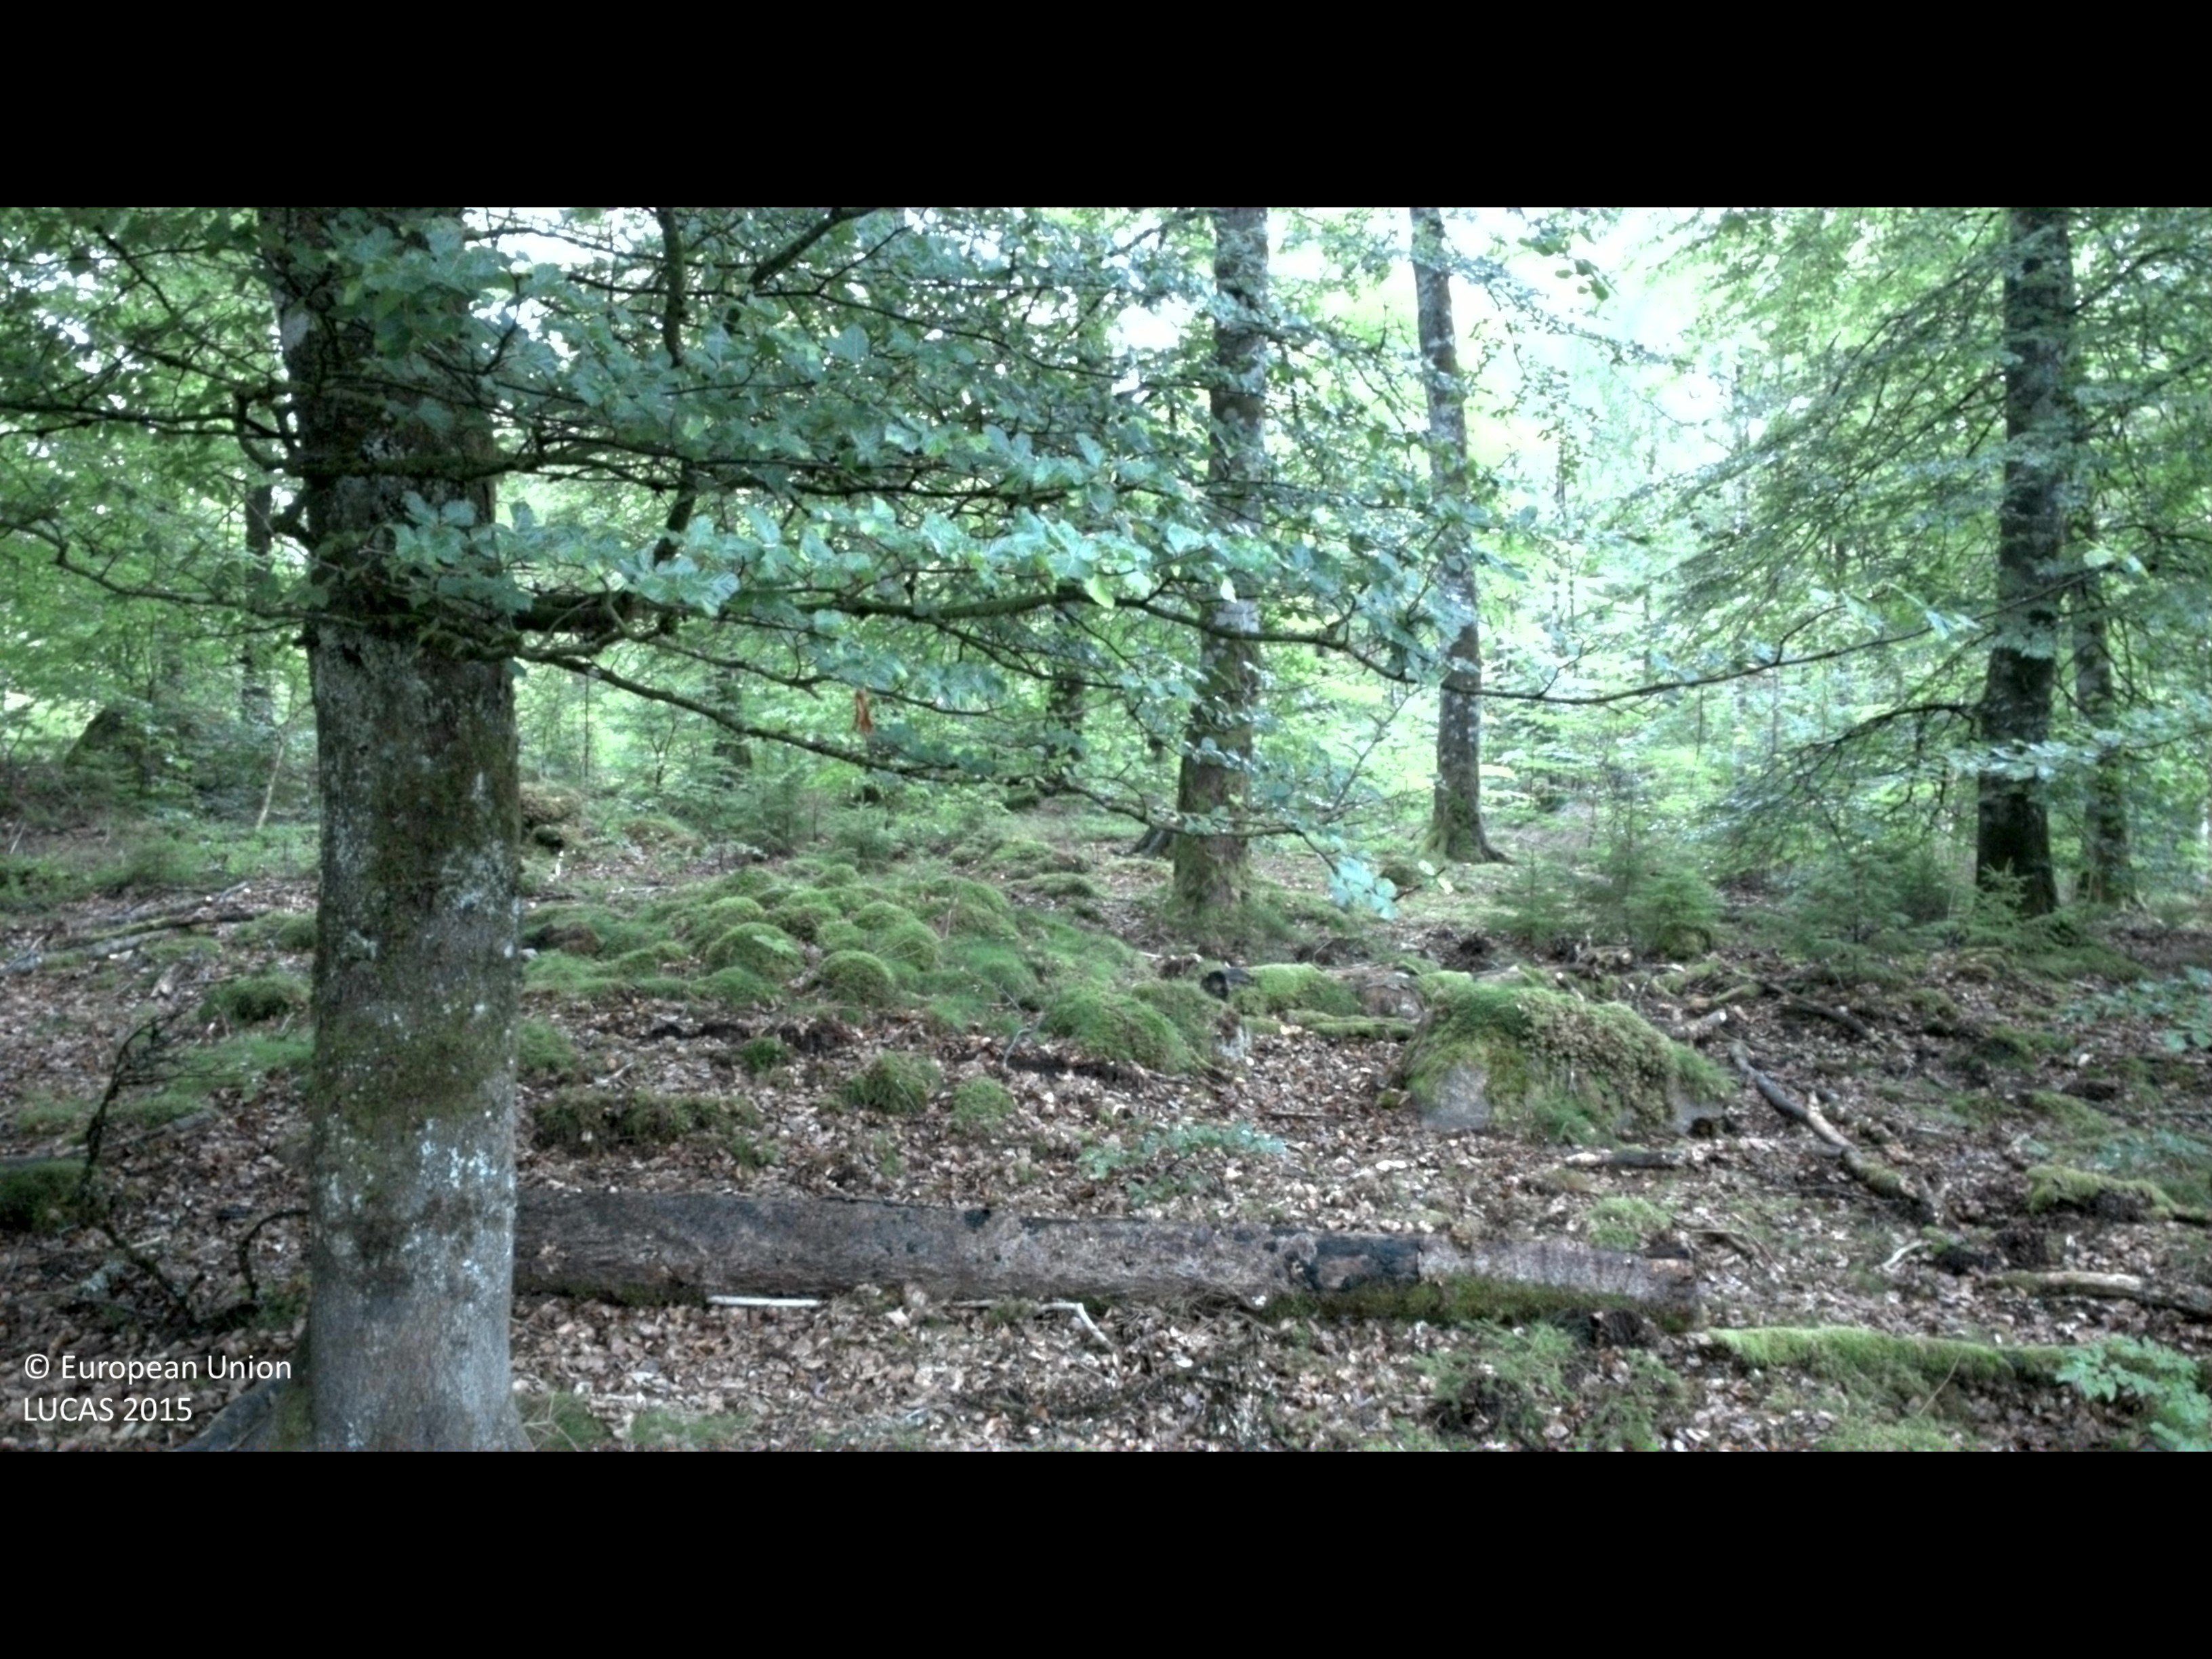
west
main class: Woodland
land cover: Broadleaved woodland
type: beech forest
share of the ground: > 75 %
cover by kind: broadleaved forest trees 75 %, lichens and mosses 5 %
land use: Forestry
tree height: > 5 m
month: August
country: SE
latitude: 57.1372
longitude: 13.8791
